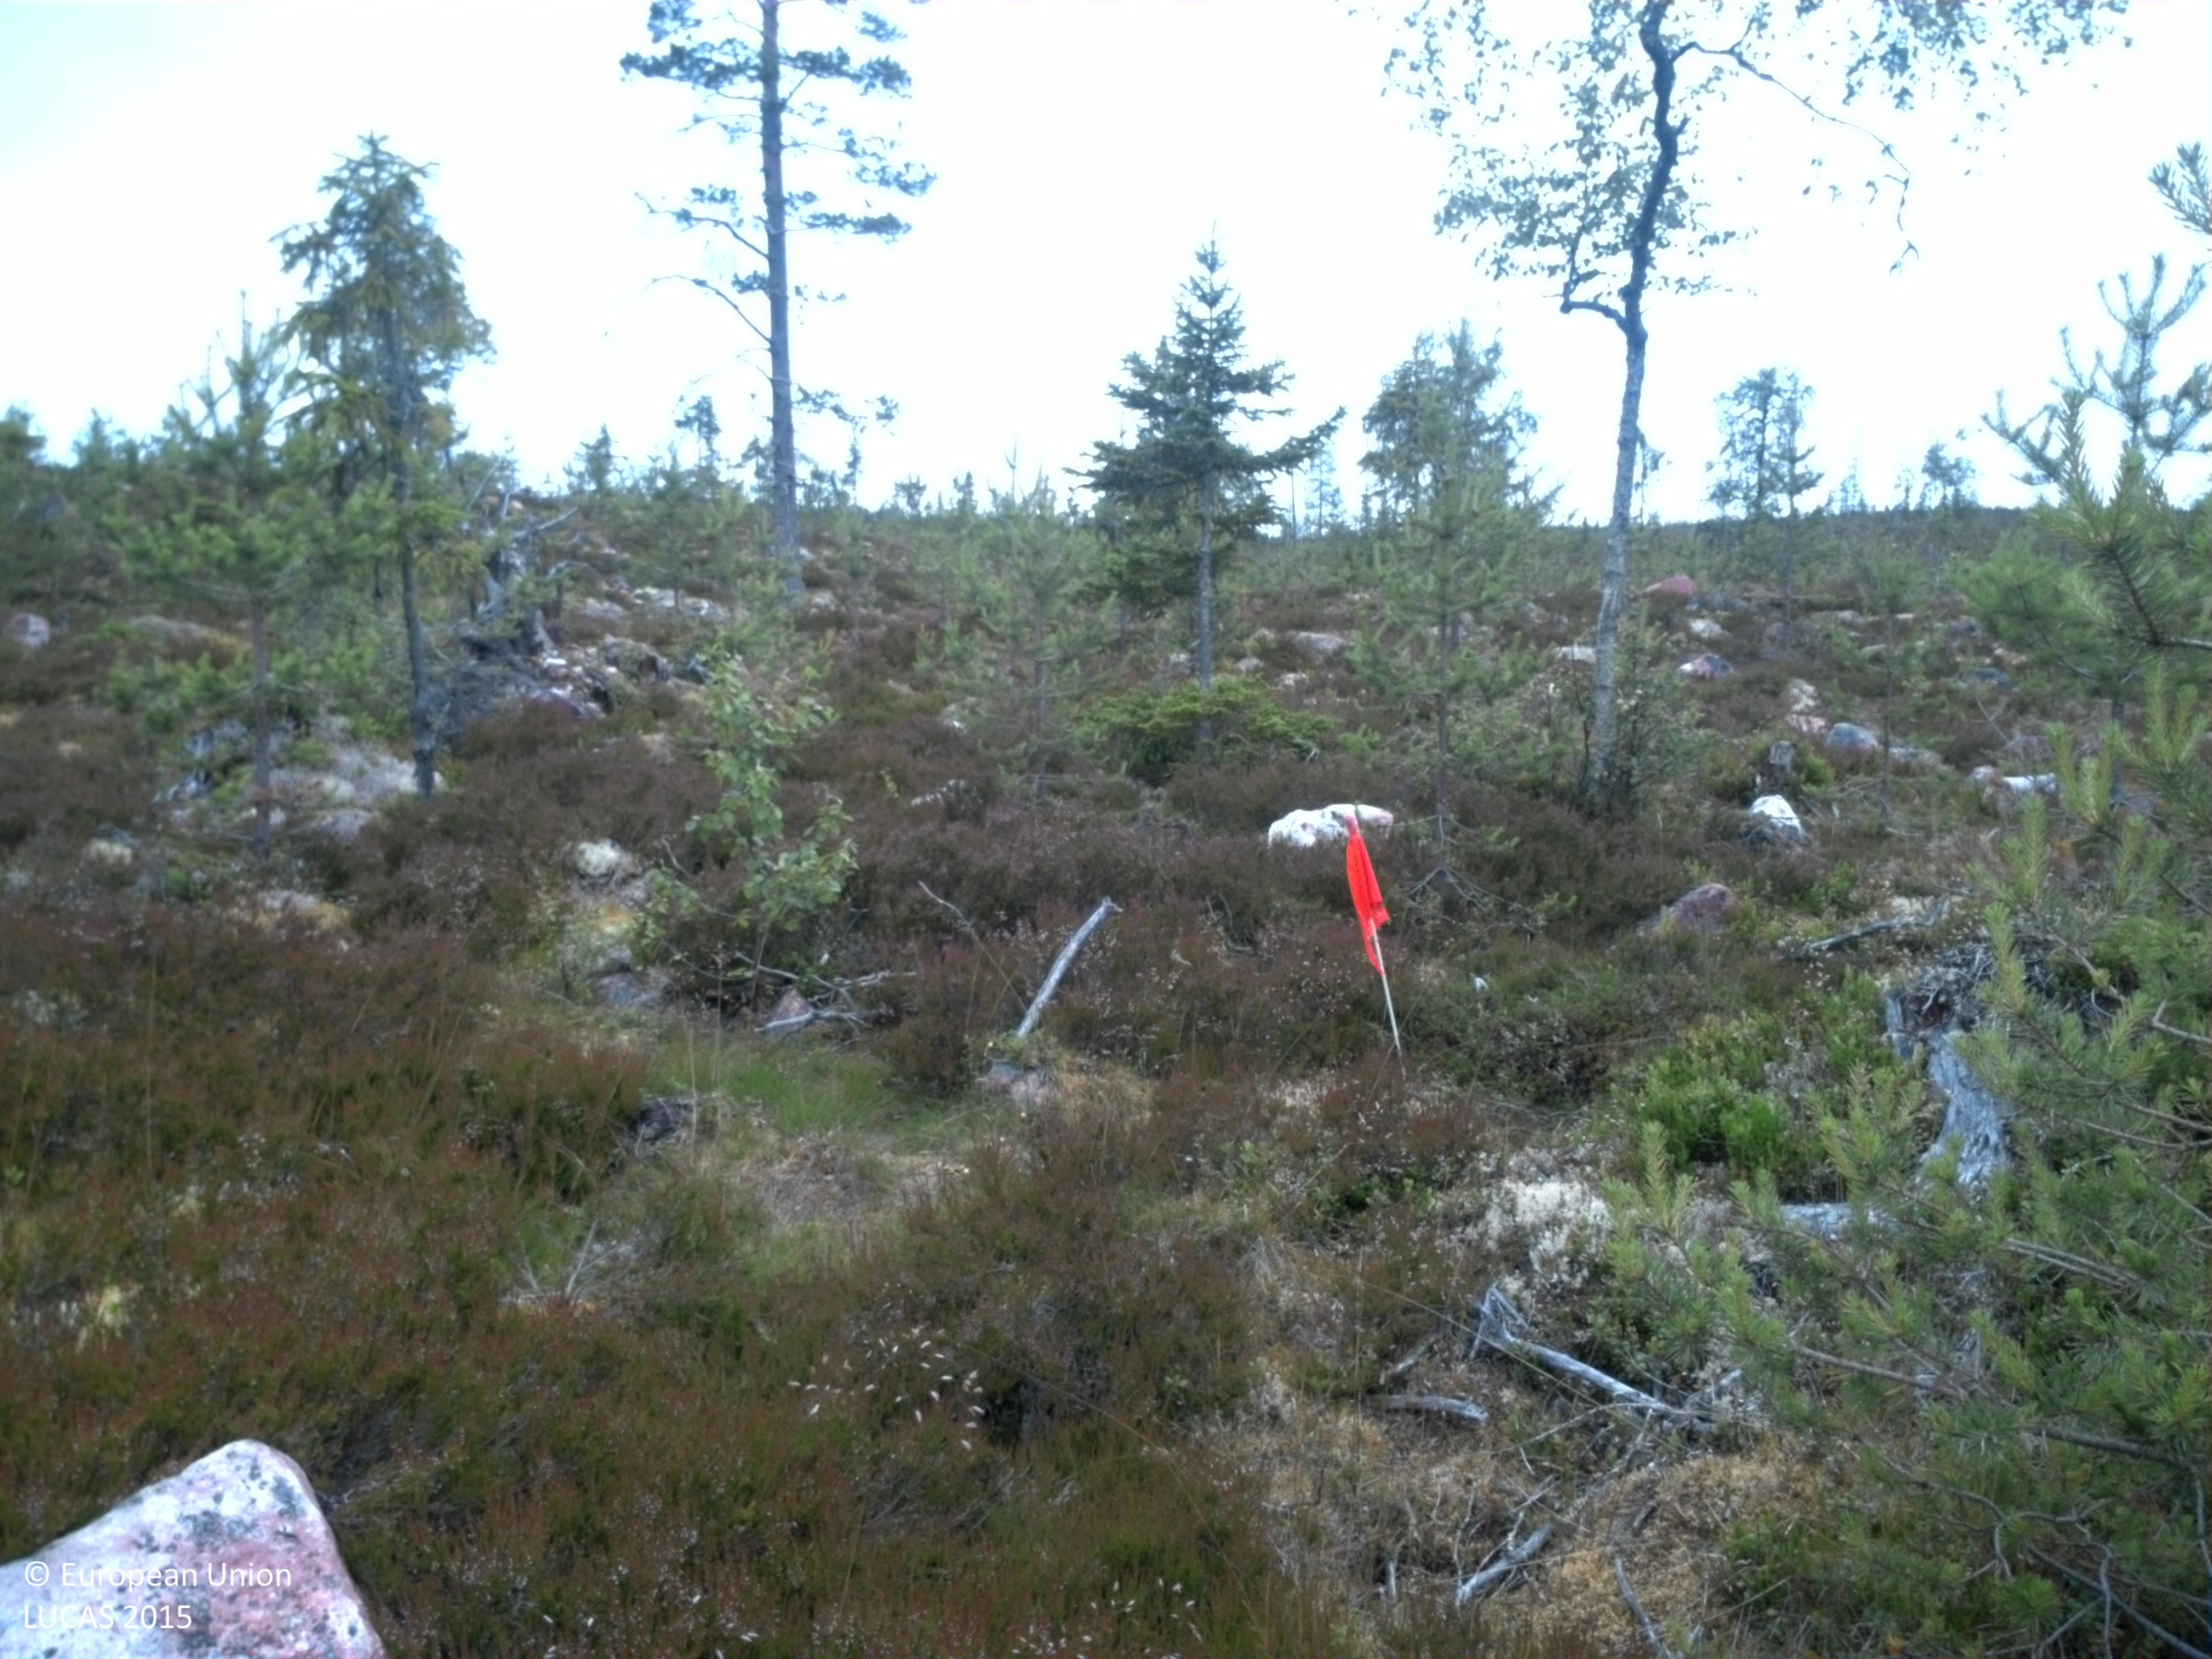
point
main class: Woodland
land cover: Pine dominated coniferous woodland
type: boreal forest
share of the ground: 10 - 25 %
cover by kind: shrubs 40 %, coniferous forest trees 20 %, consolidated bare surface 20 %, lichens and mosses 10 %, broadleaved forest trees 5 %, herbaceous plants 5 %
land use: Forestry
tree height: < 5 m
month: August
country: SE
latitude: 61.5762
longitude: 14.2979
